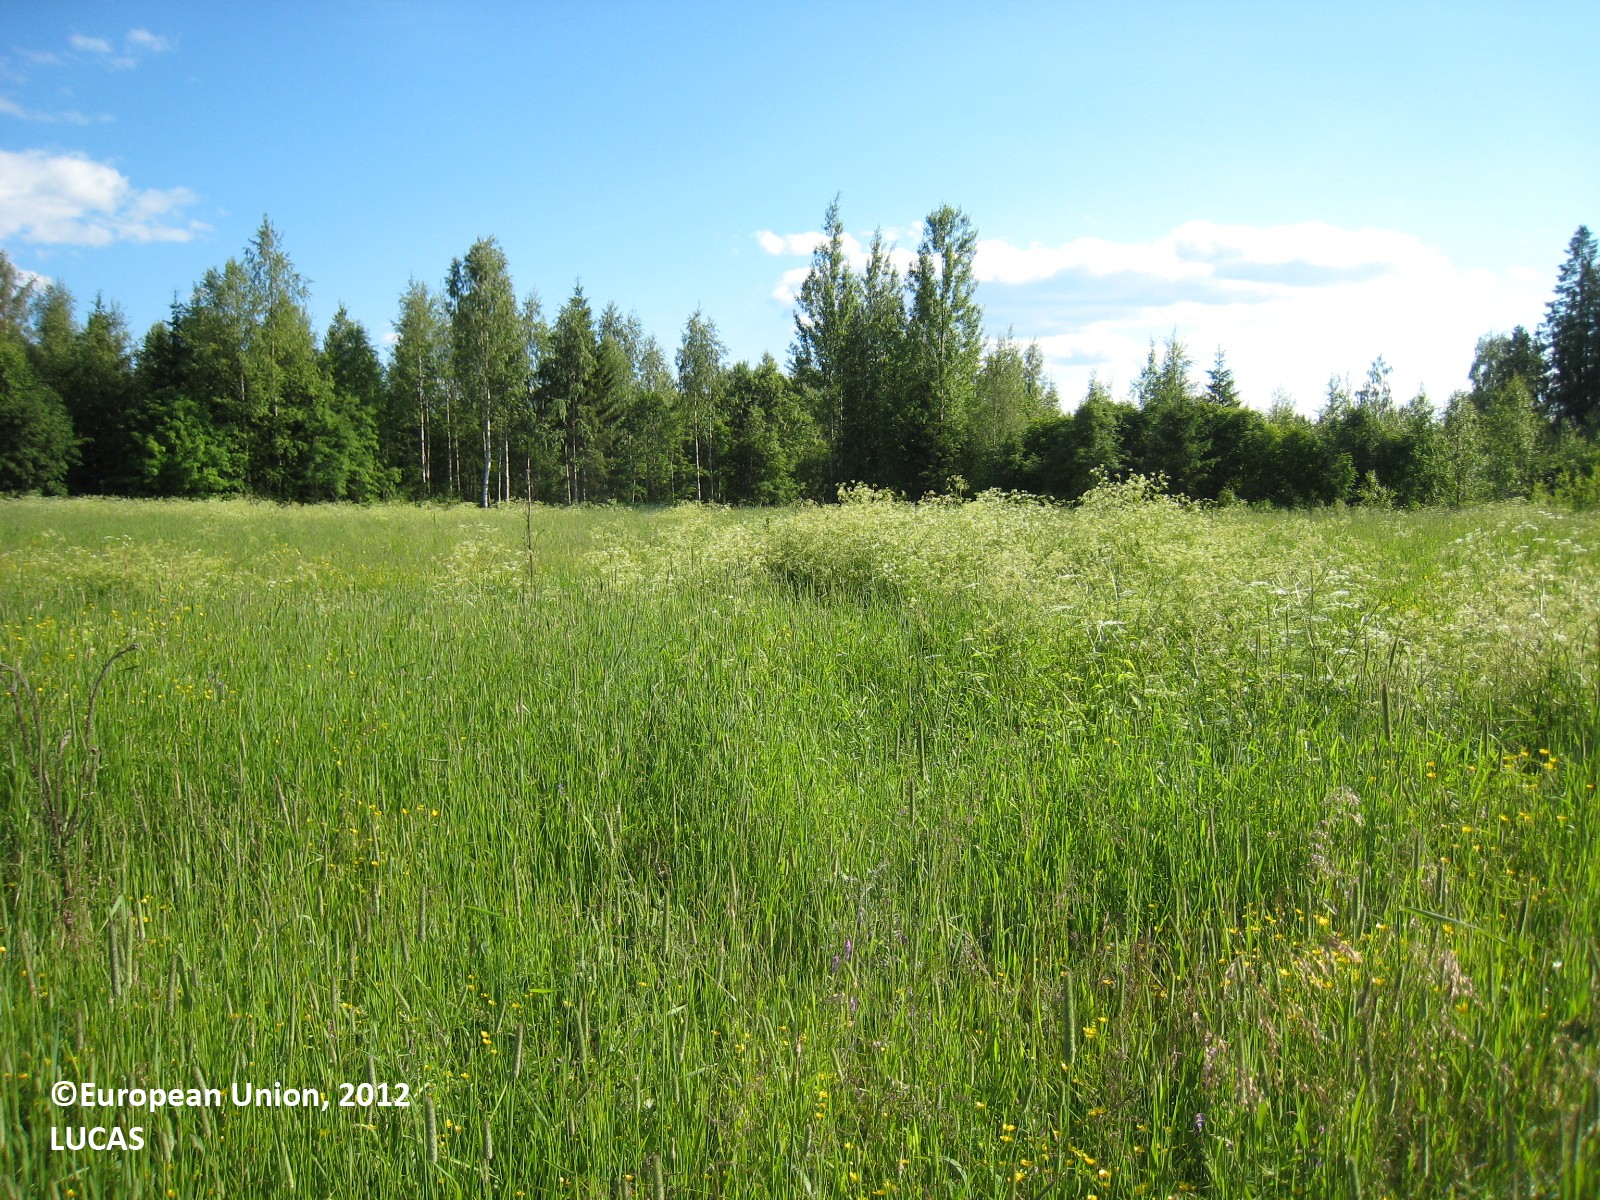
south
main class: Cropland
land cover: Temporary grasslands
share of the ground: > 75 %
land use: Agriculture (excluding fallow land and kitchen gardens)
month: July
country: FI
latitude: 62.6385
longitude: 26.1383
